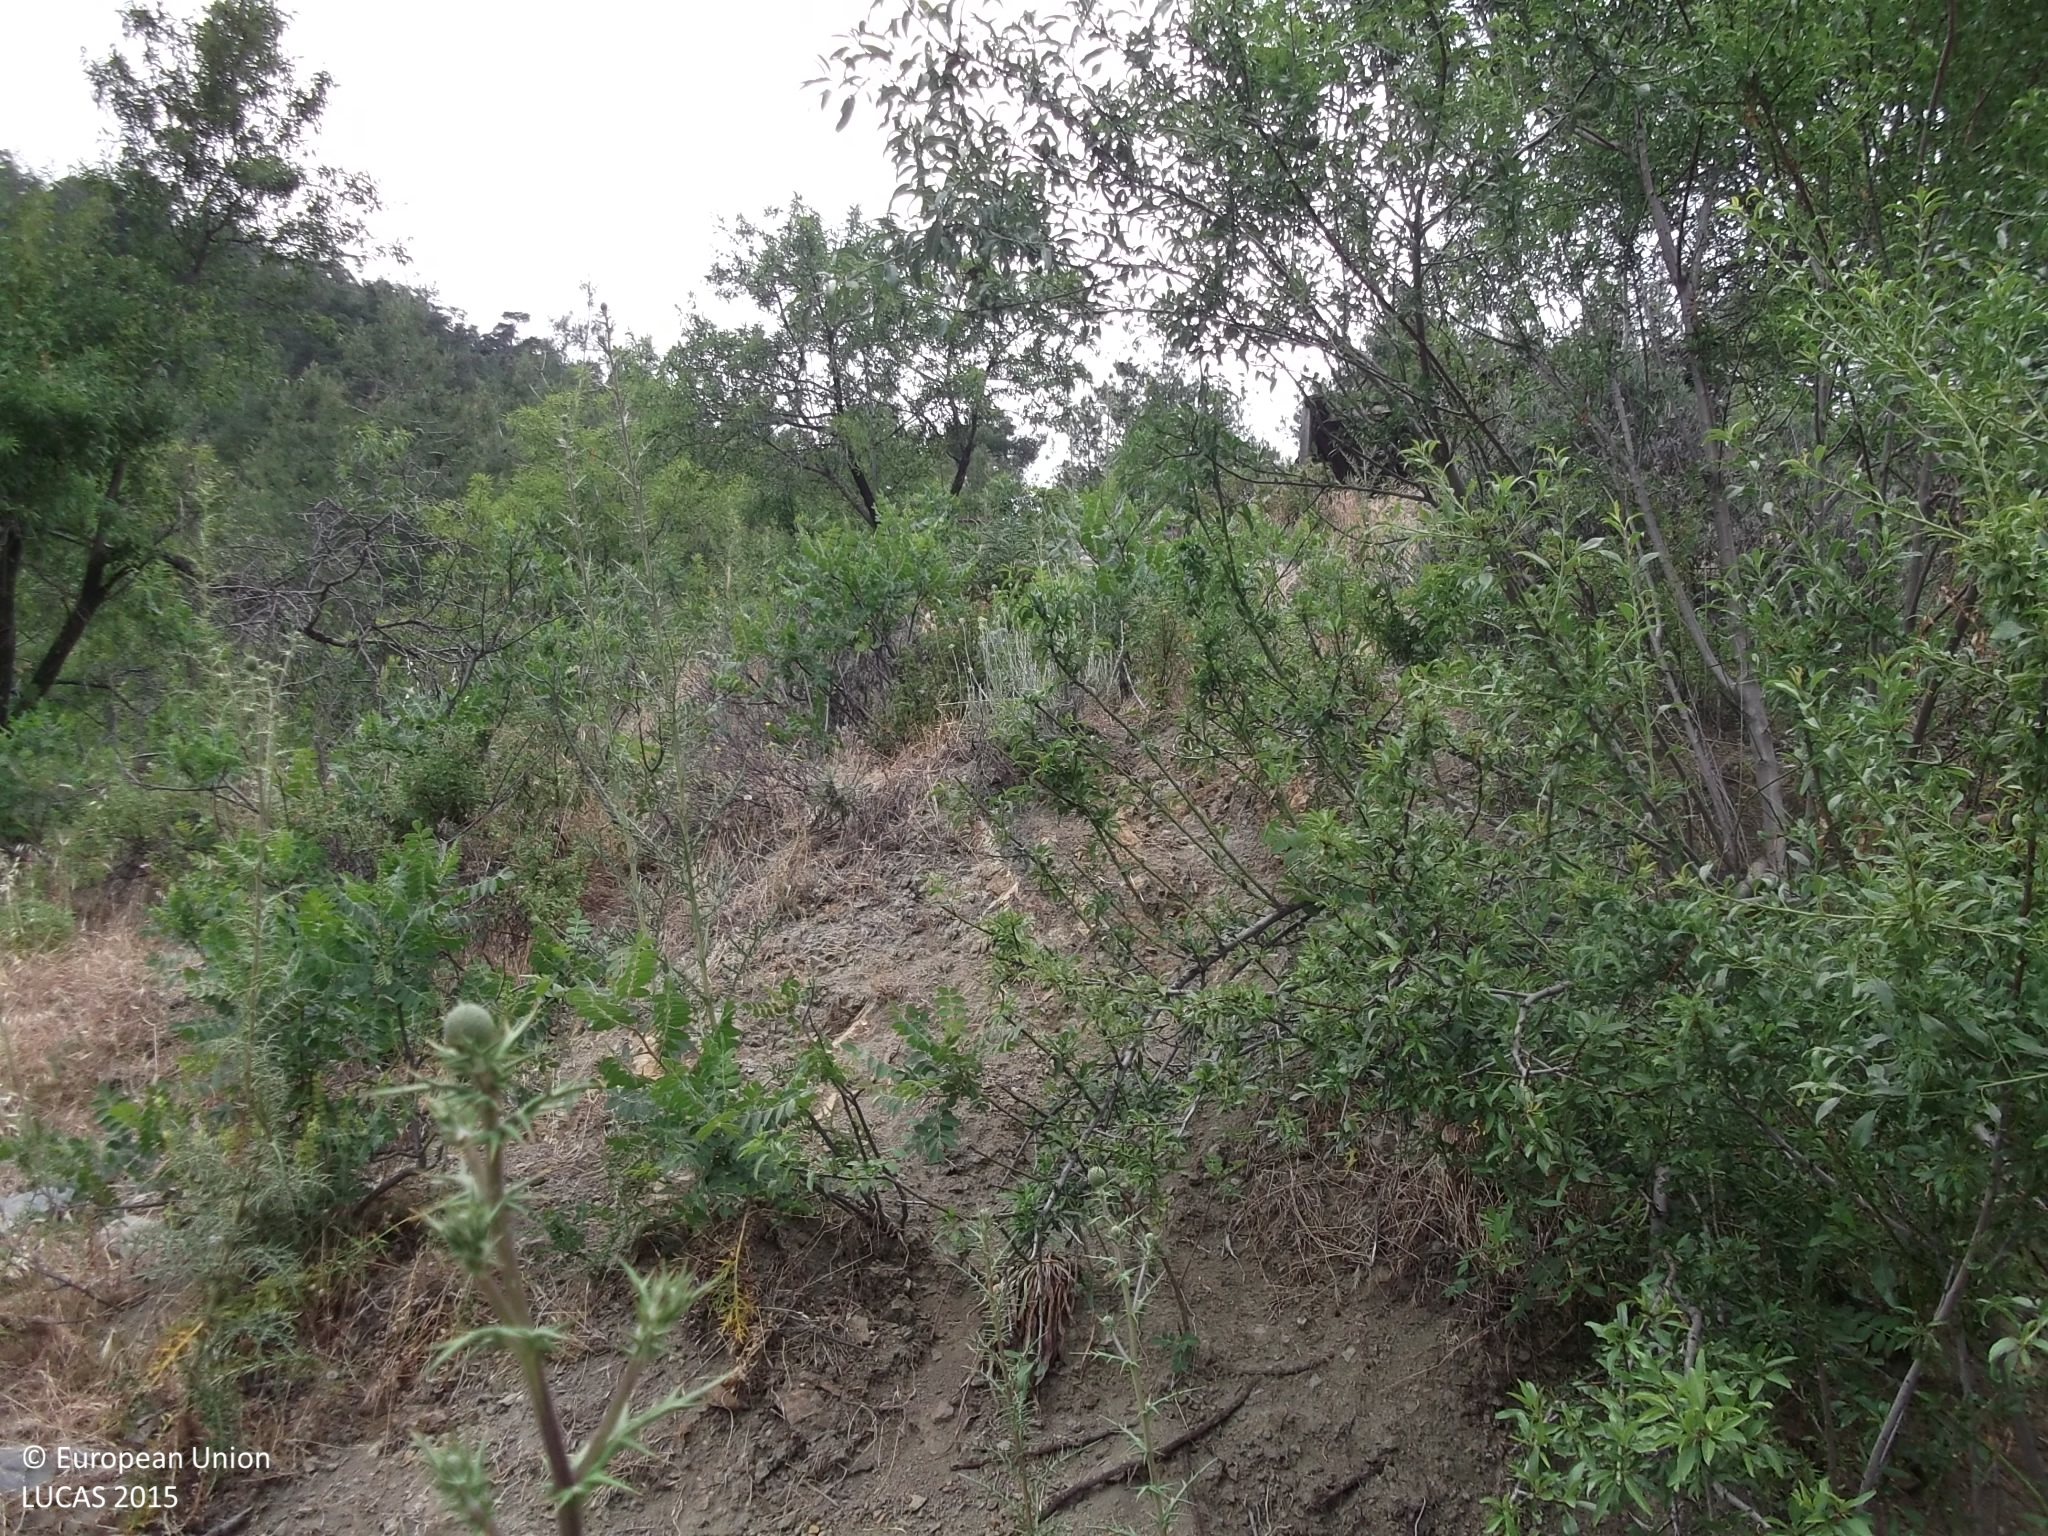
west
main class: Woodland
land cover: Pine dominated coniferous woodland
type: coniferous forest of the mediterranean region
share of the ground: > 75 %
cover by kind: coniferous forest trees 80 %, shrubs 10 %, herbaceous plants 10 %
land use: Forestry
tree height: > 5 m
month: June
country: CY
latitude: 34.9783
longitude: 33.0125
